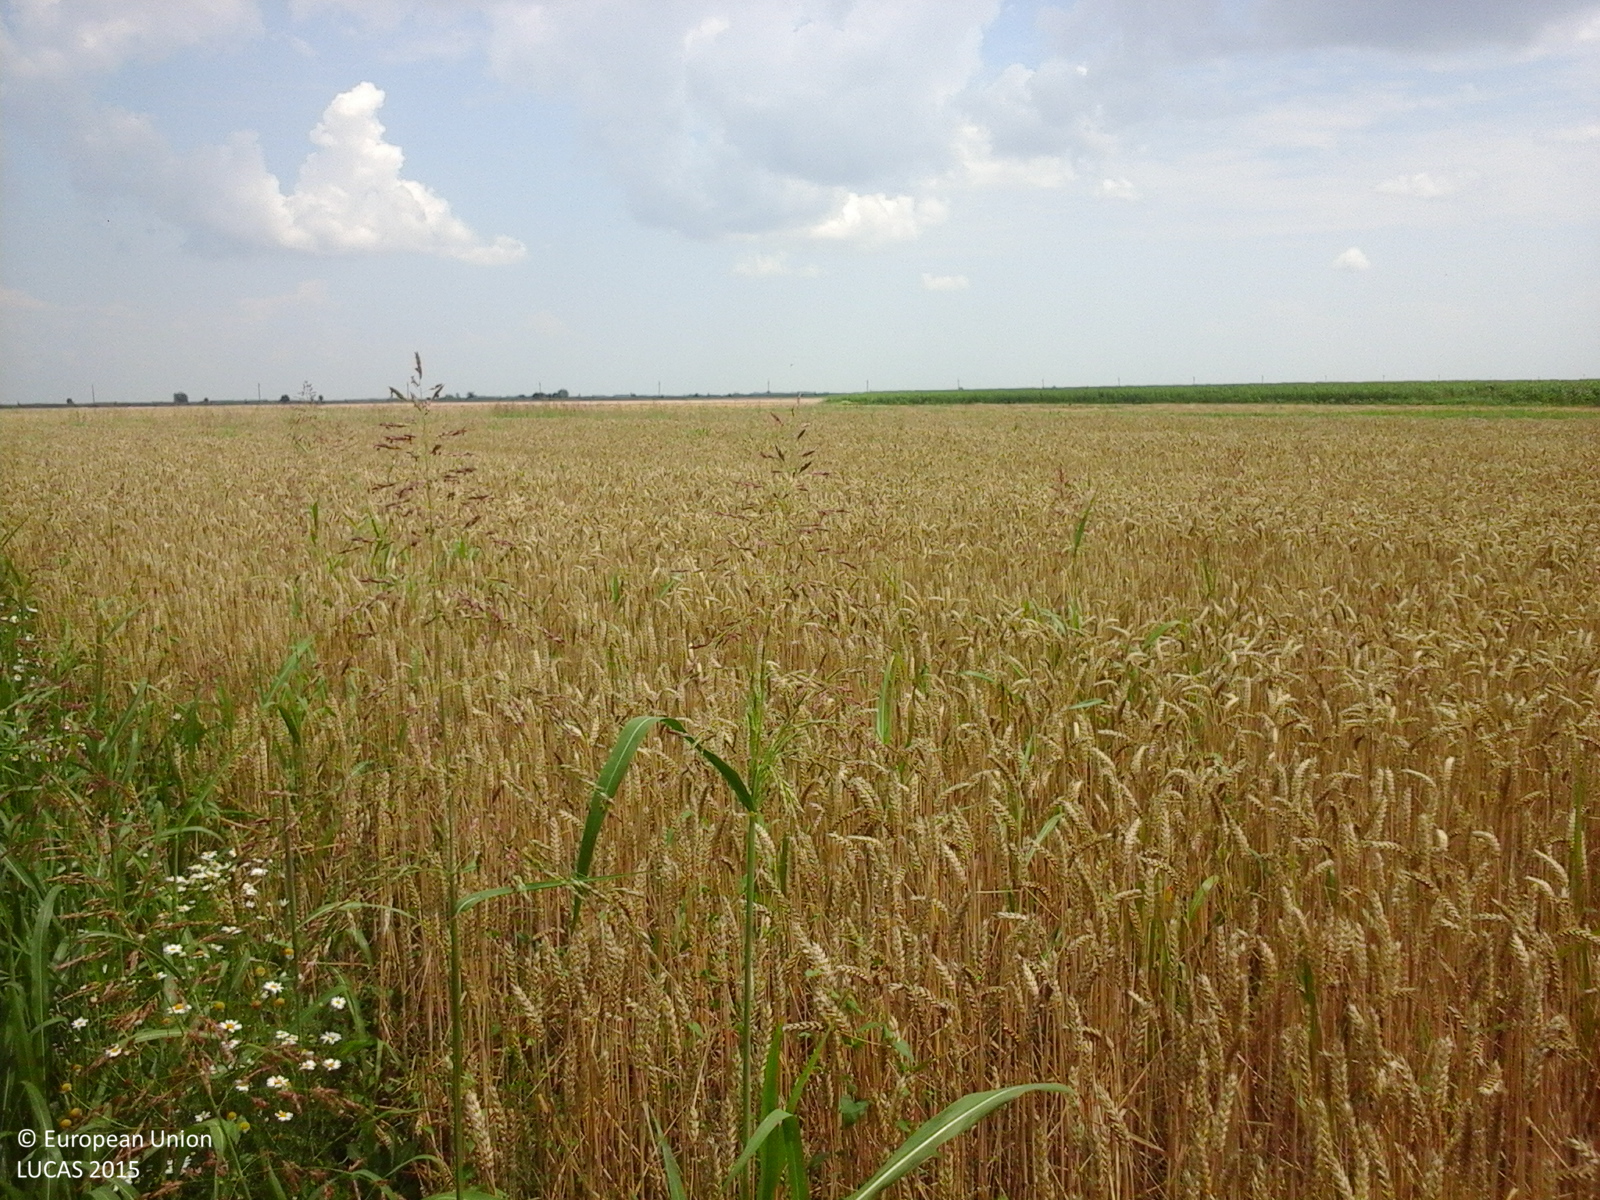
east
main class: Cropland
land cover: Sunflower
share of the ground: > 75 %
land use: Agriculture (excluding fallow land and kitchen gardens)
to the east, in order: Sunflower; Grass margins; Common wheat; Grass margins; Paved roads, cycling and walking lanes; Grass margins; Rape and turnip rape
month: July
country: RO
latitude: 43.9718
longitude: 25.5823
